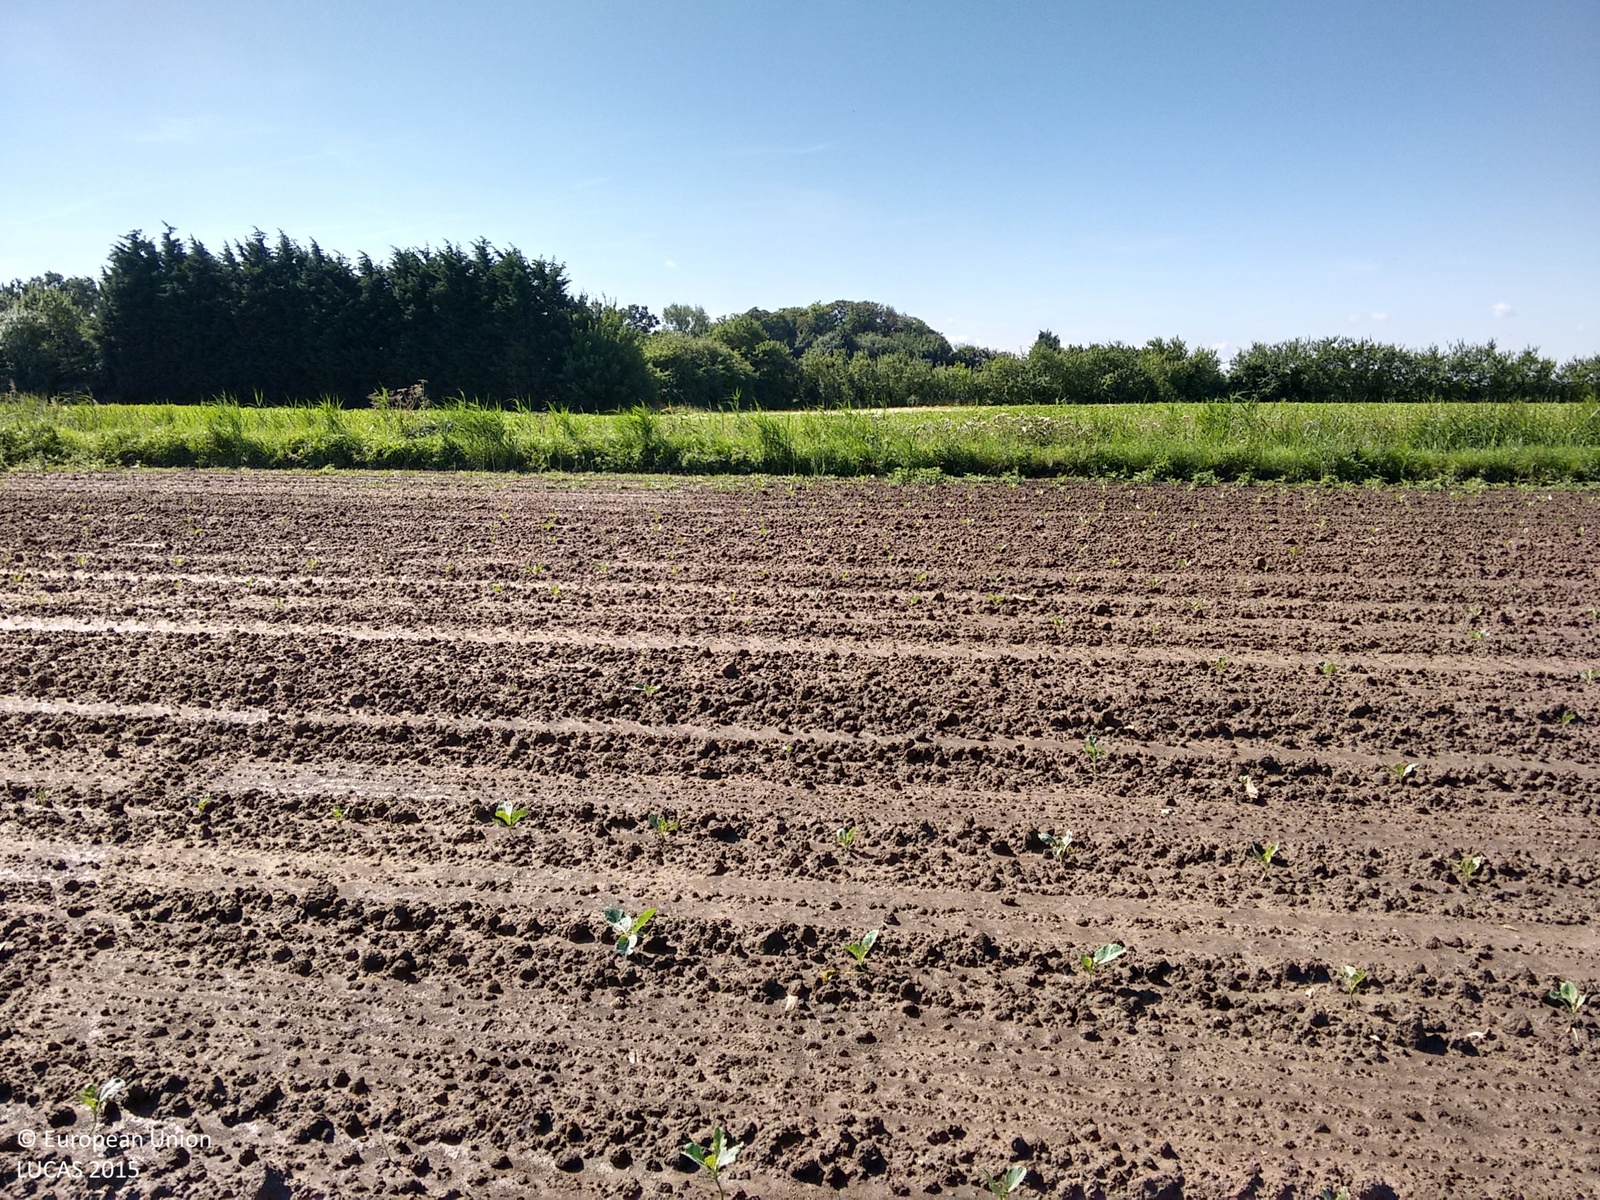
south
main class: Cropland
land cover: Other fresh vegetables
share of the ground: < 10 %
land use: Agriculture (excluding fallow land and kitchen gardens)
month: July
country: GB
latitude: 52.6187
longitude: 0.1466
